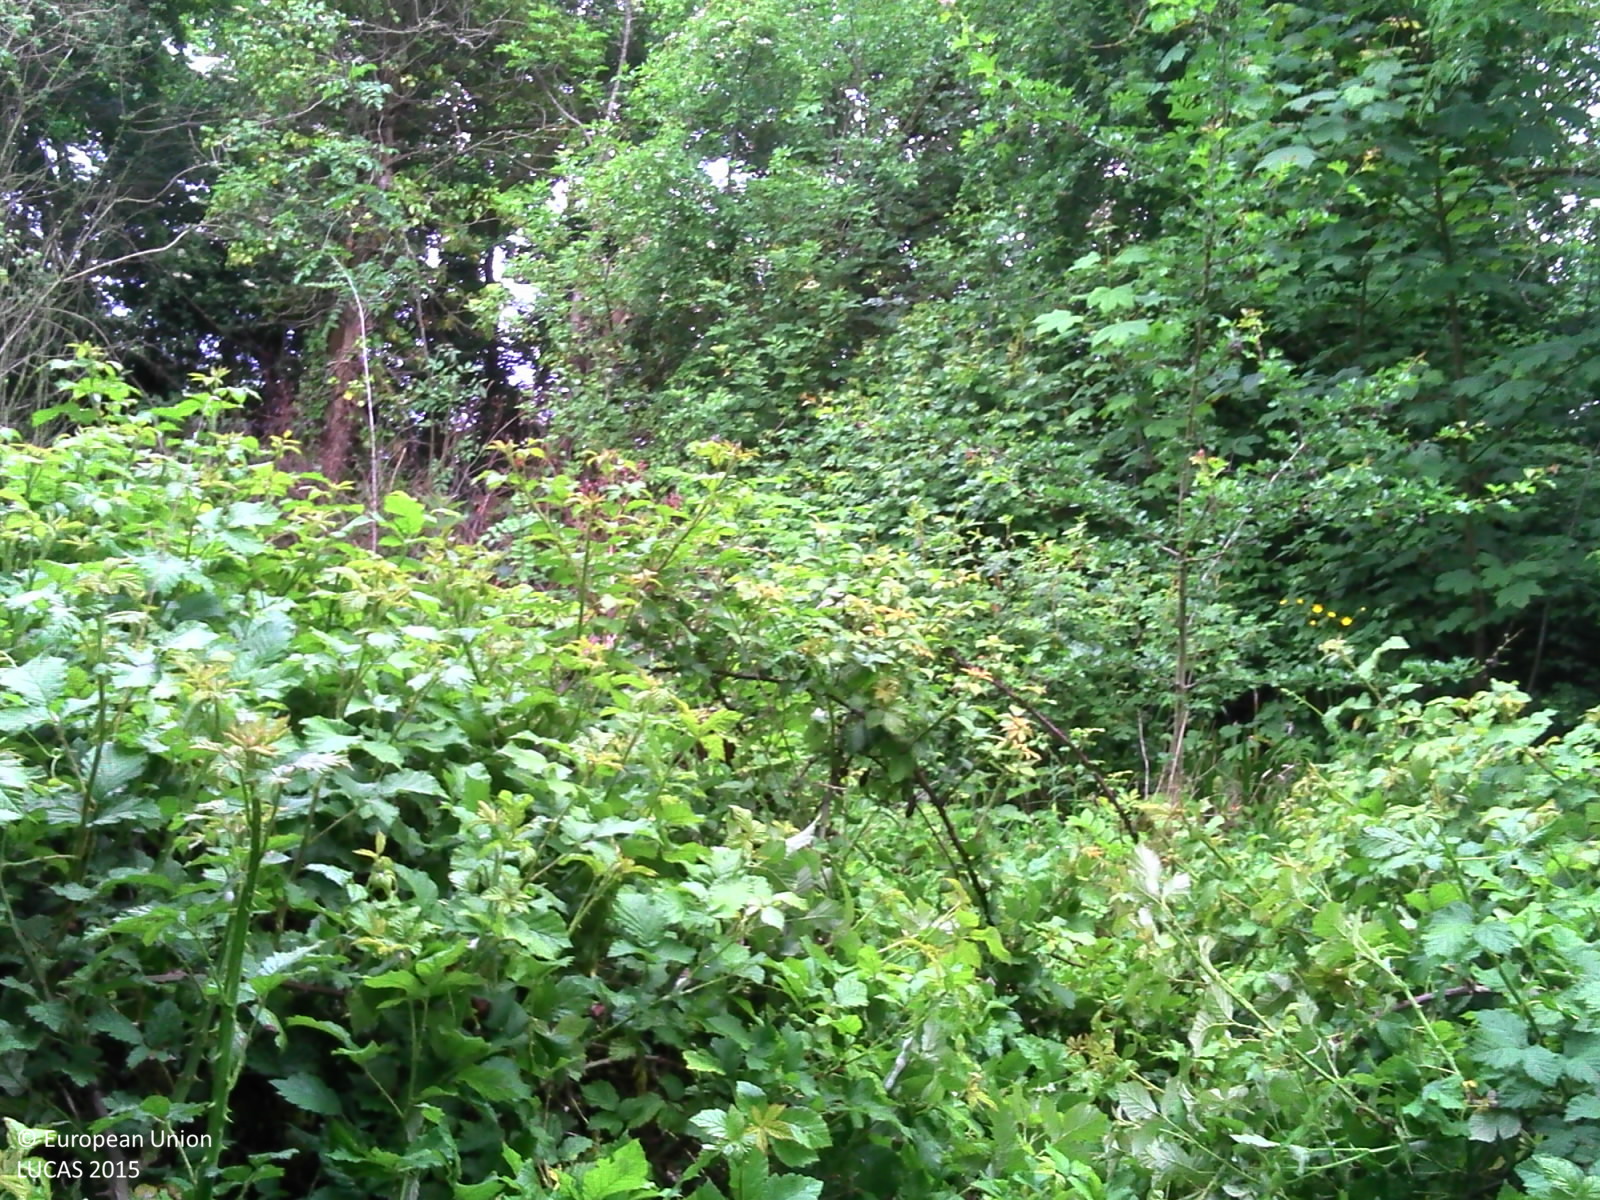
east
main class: Woodland
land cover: Broadleaved woodland
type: mesophytic deciduous forest
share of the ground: > 75 %
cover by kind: broadleaved forest trees 75 %, shrubs 20 %, herbaceous plants 5 %
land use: Semi-natural and natural areas not in use
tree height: > 5 m
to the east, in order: Broadleaved woodland; Tracks; Lines of trees; Grassland without tree/shrub cover; Artificial constructions in urban areas; Other bare soil; Artificial constructions in urban areas
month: May
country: FR
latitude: 49.3116
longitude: -0.3652
